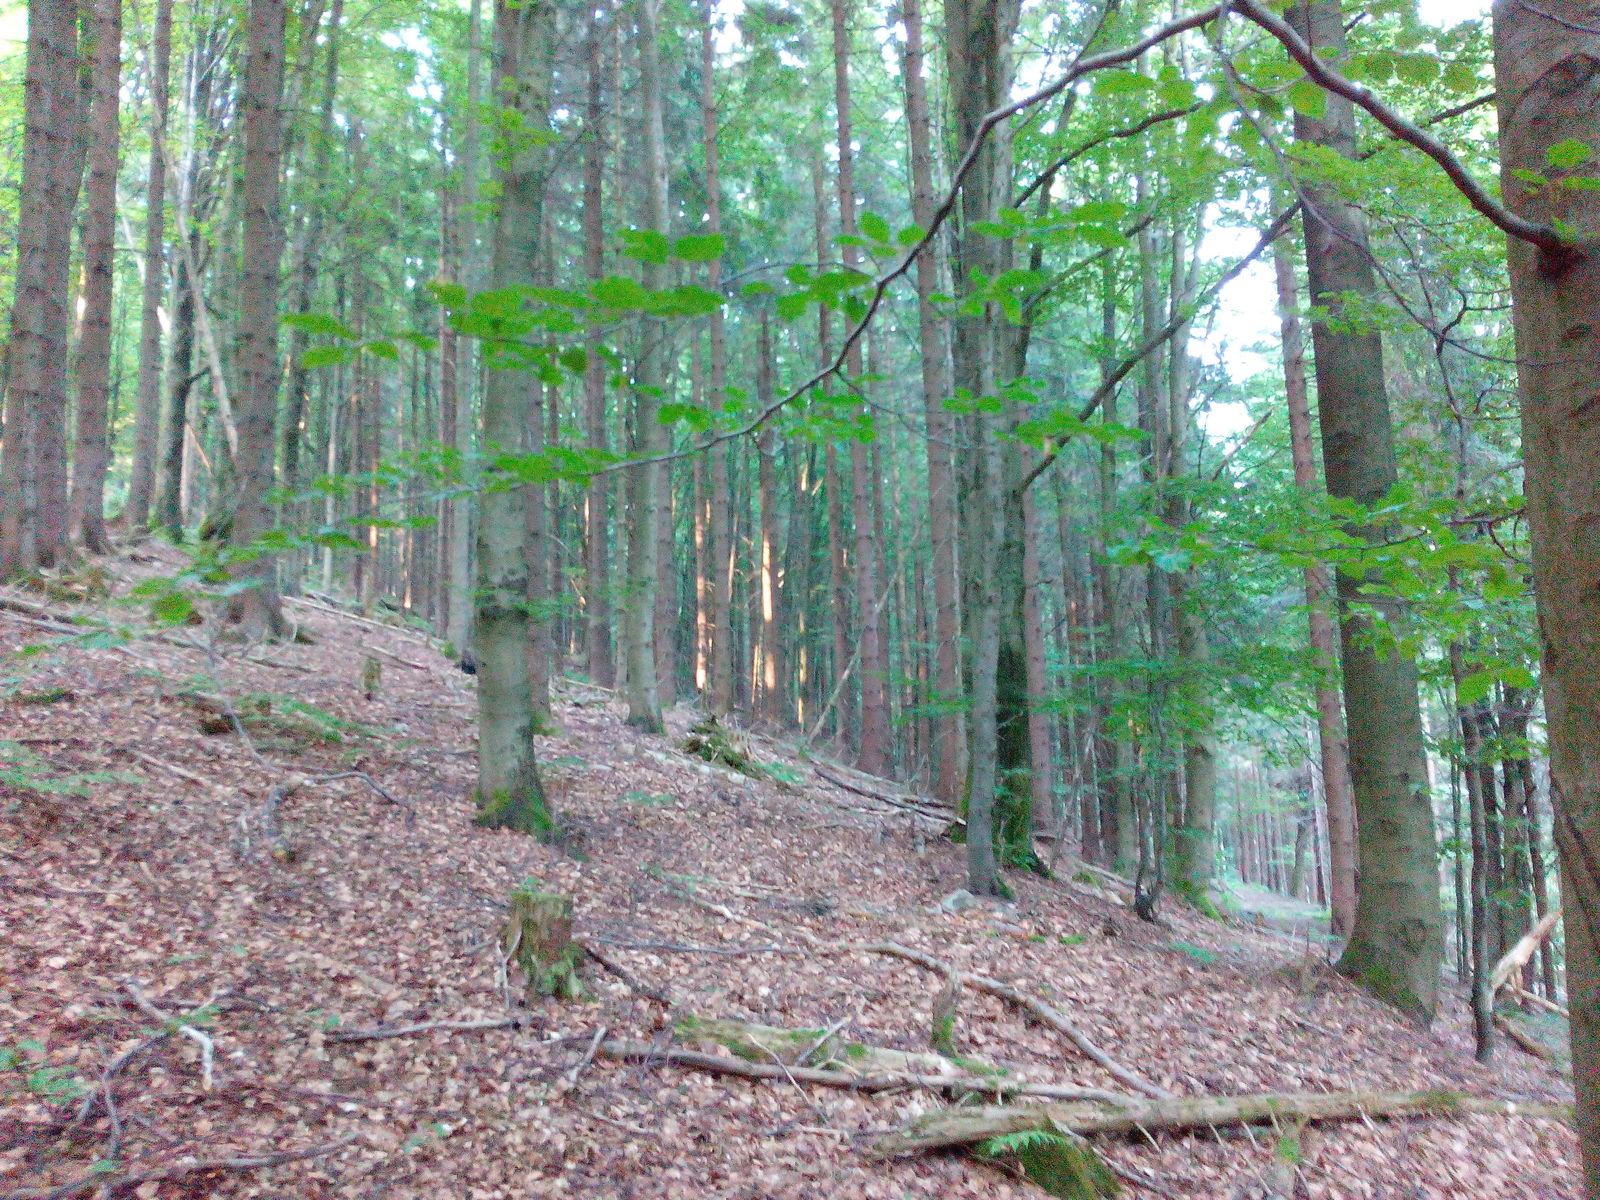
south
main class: Woodland
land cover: Spruce dominated mixed woodland
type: hemiboreal forest and nemoral coniferous forest and mixed broadleaved-coniferous forest
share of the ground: > 75 %
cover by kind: coniferous forest trees 50 %, broadleaved forest trees 50 %
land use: Forestry
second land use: Amenities, museums, leisure
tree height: > 5 m
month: July
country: DE
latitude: 50.6307
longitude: 10.8339
